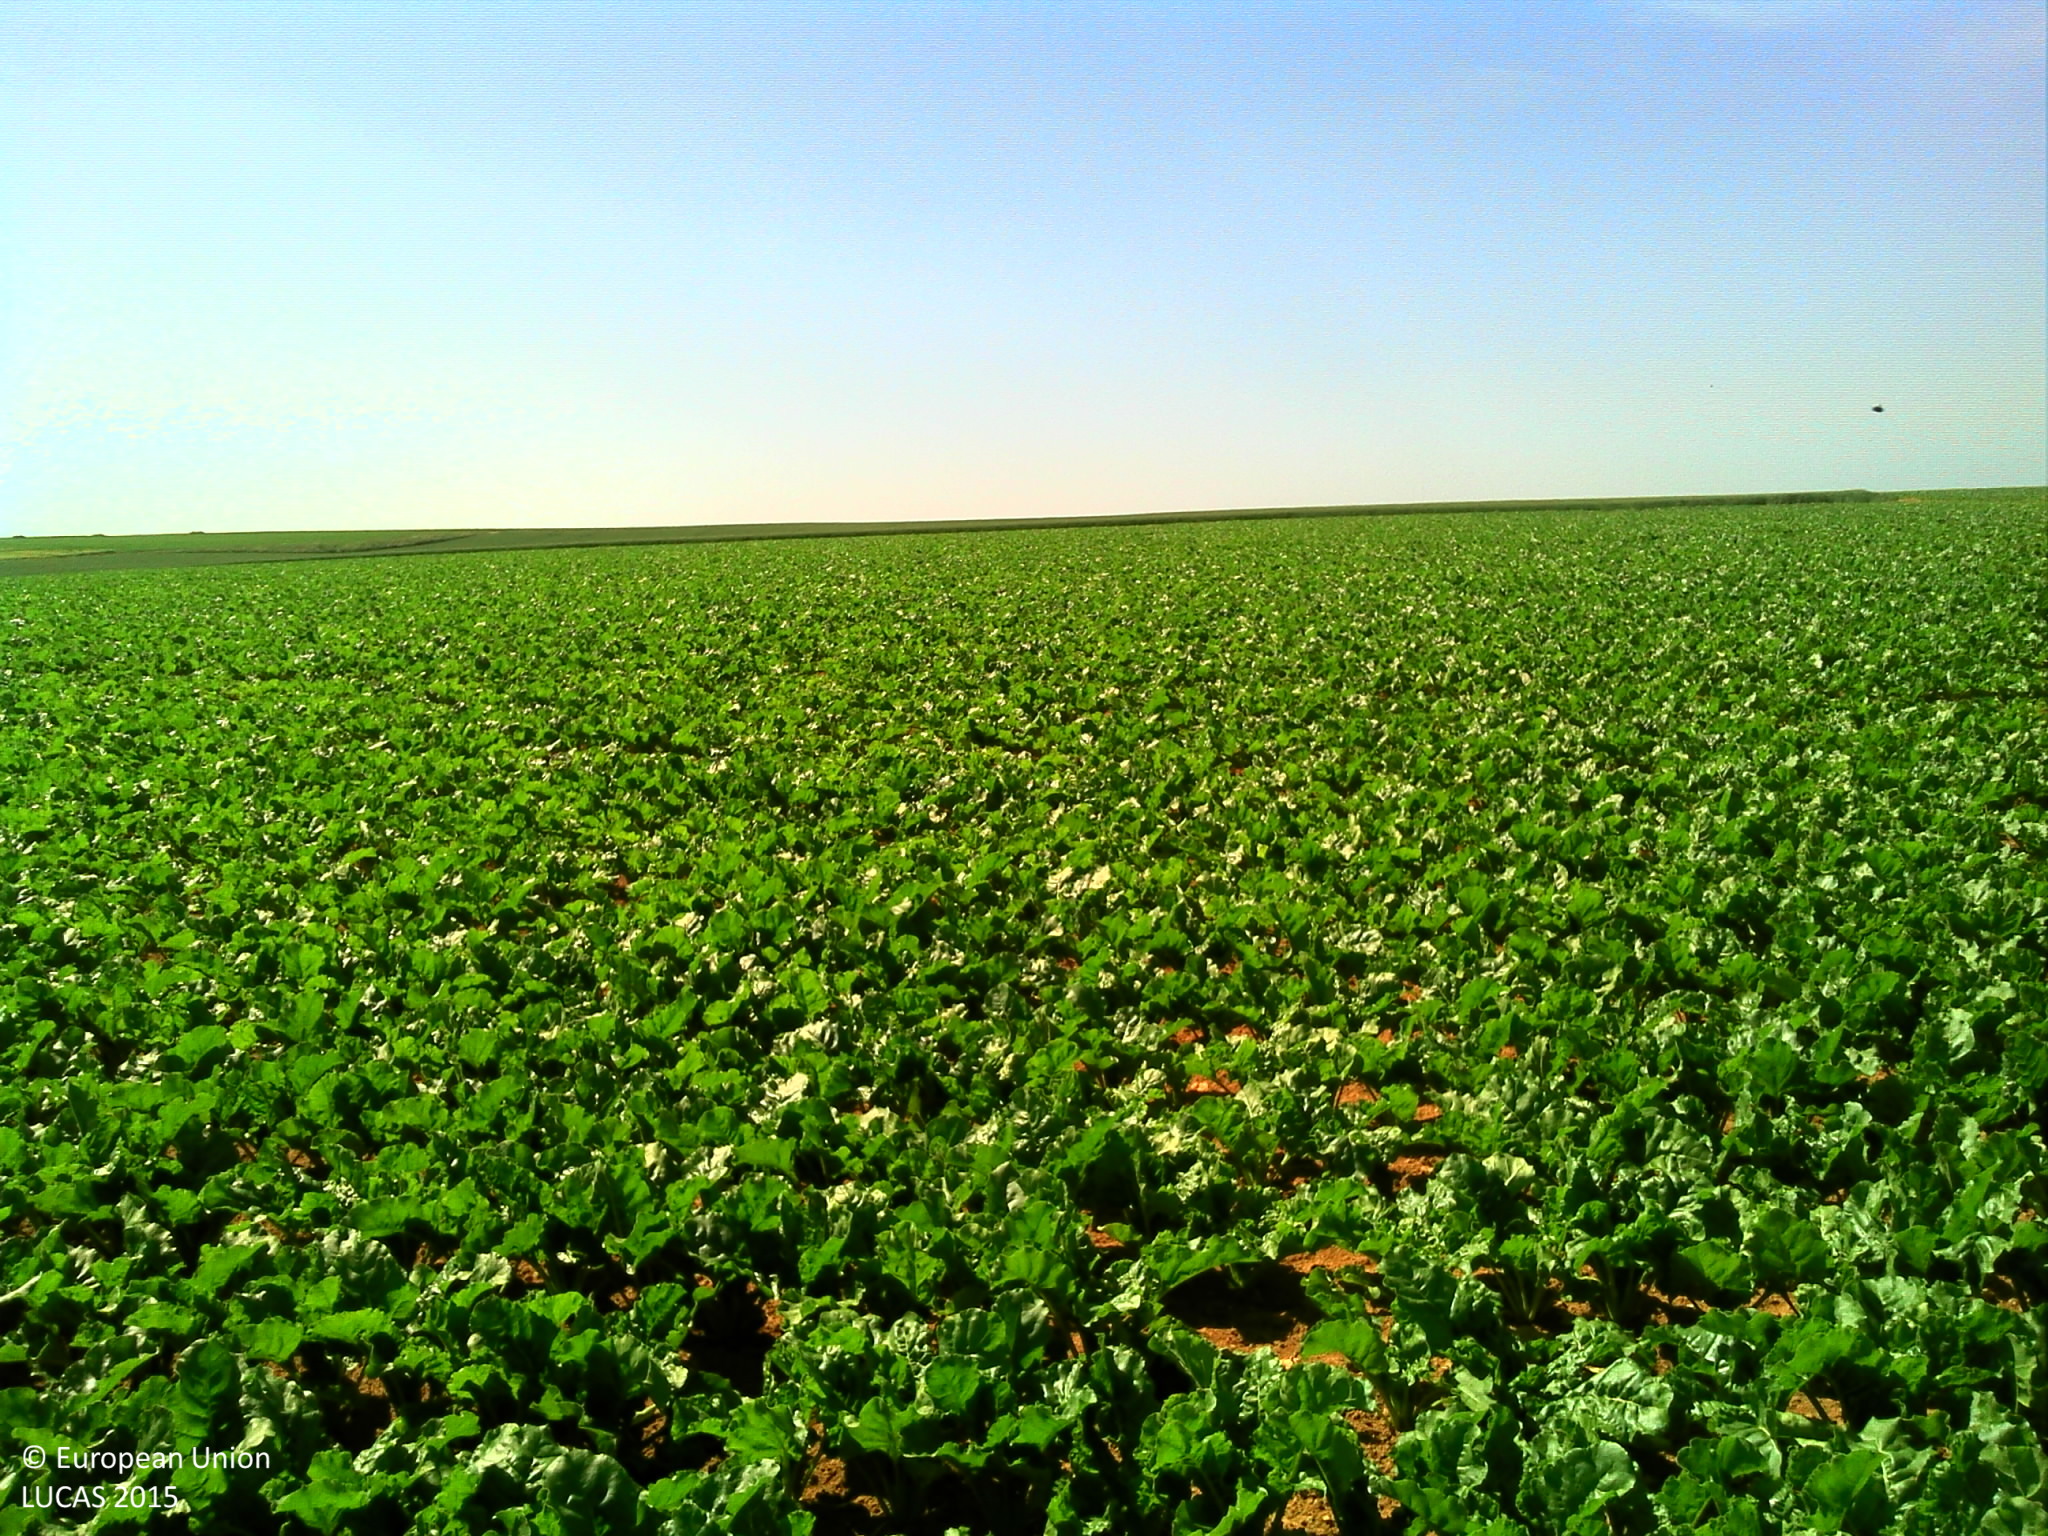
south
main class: Cropland
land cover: Sugar beet
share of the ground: > 75 %
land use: Agriculture (excluding fallow land and kitchen gardens)
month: June
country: FR
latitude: 49.4442
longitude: 3.2751
